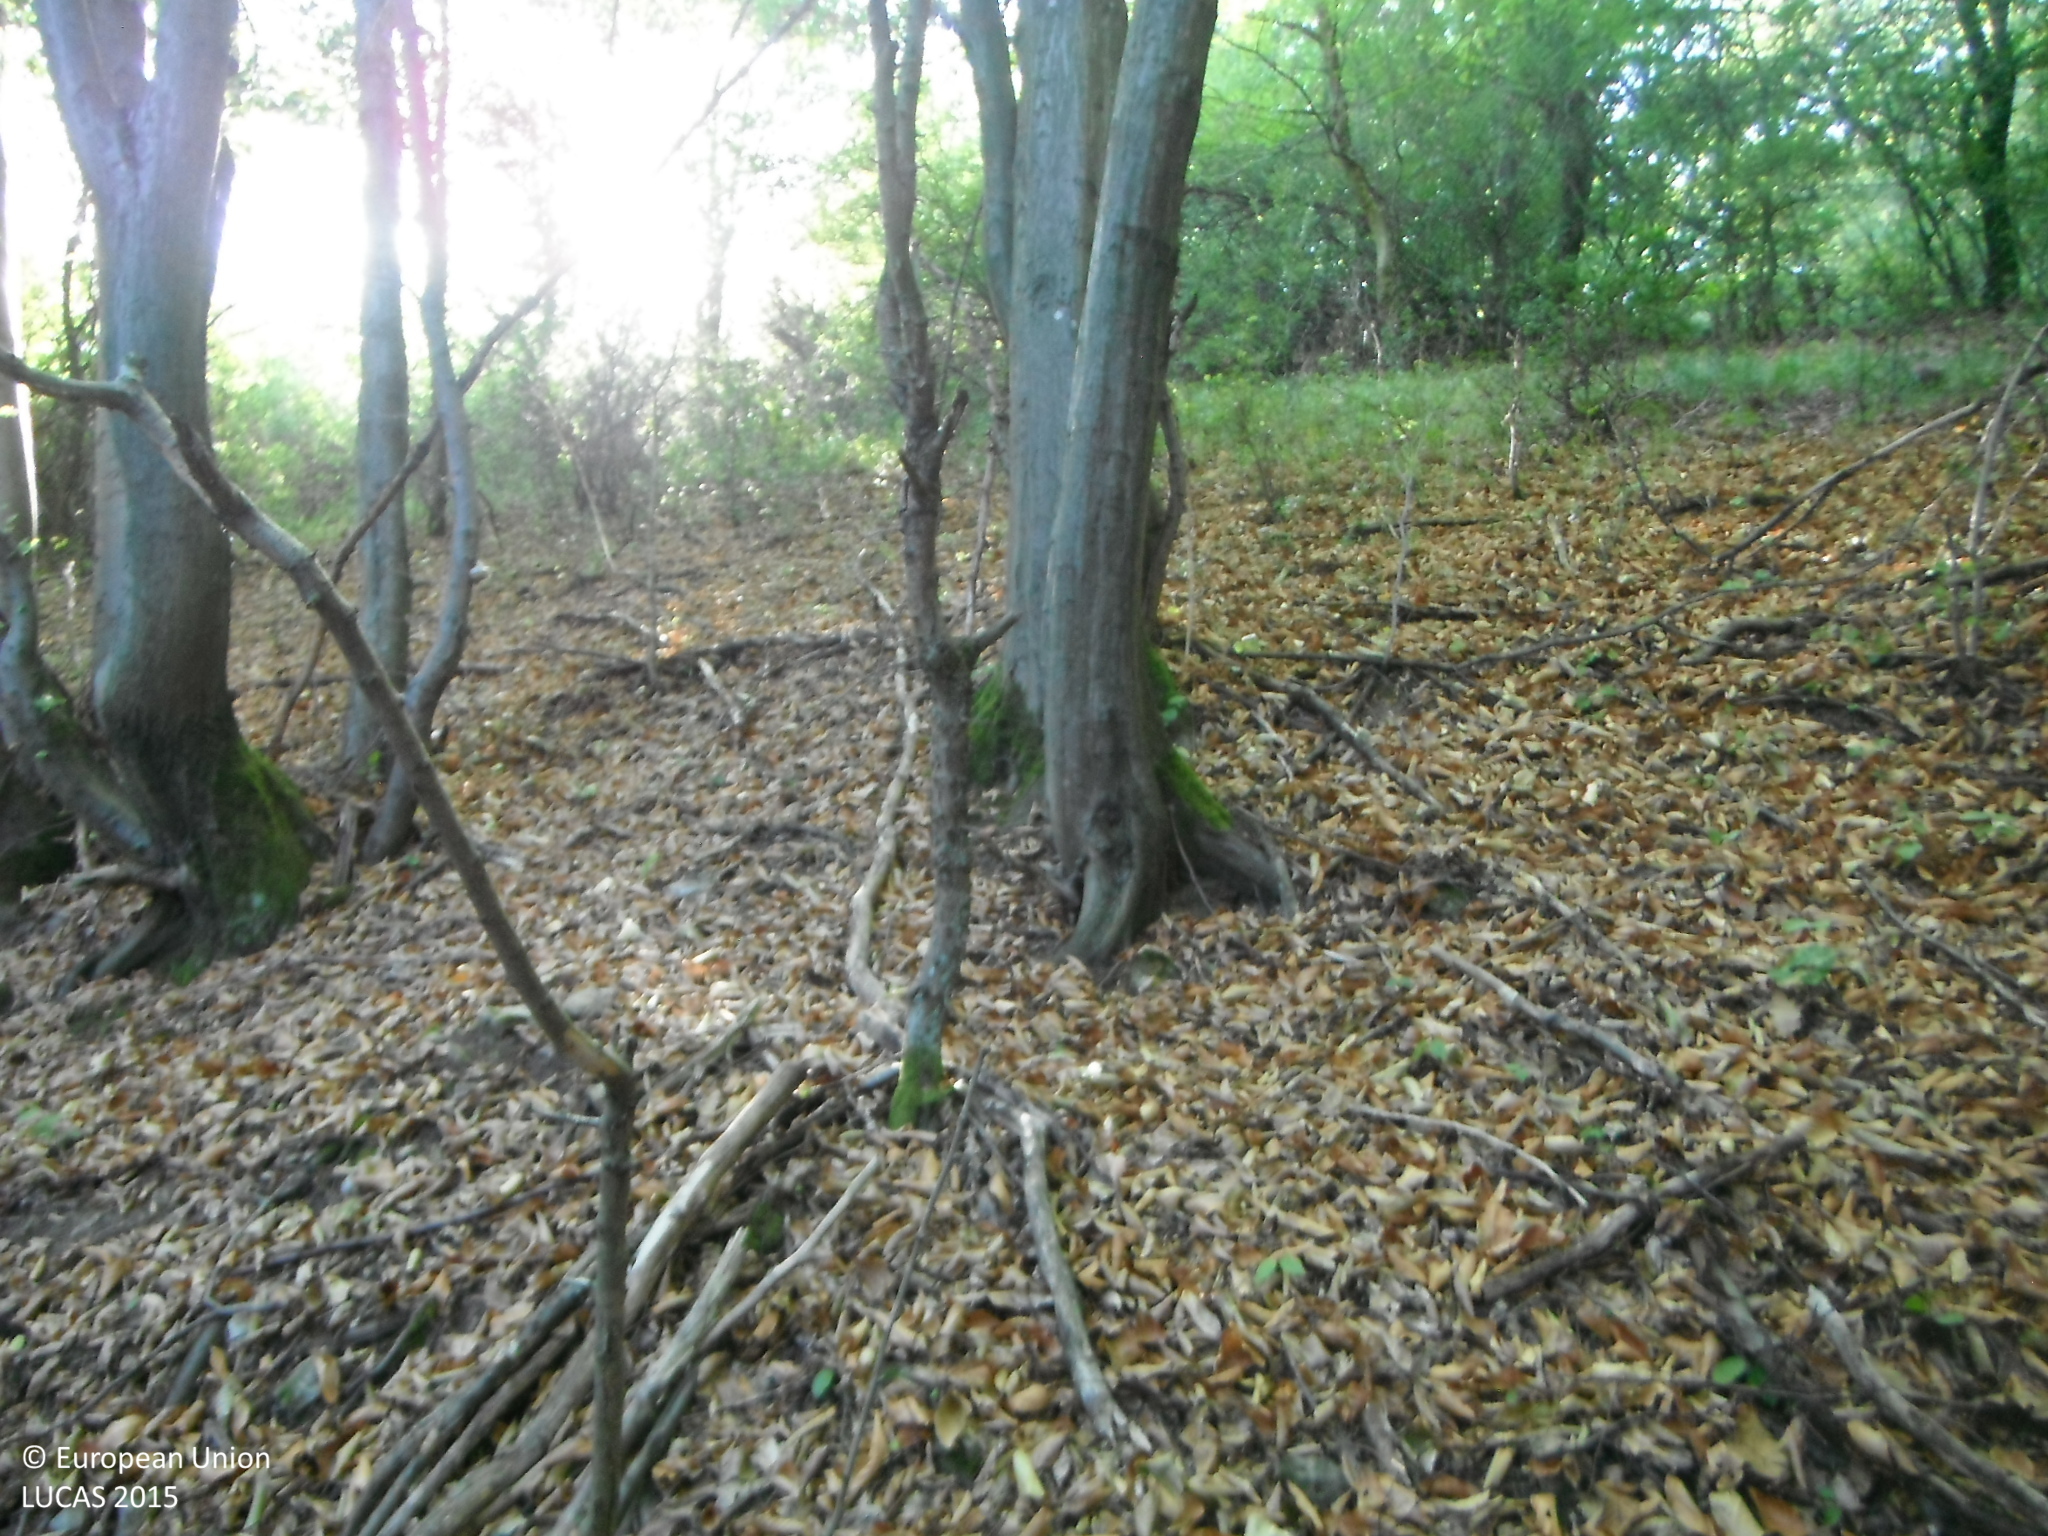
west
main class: Woodland
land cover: Broadleaved woodland
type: beech forest
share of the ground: > 75 %
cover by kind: broadleaved forest trees 90 %, shrubs 5 %
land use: Forestry
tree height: > 5 m
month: September
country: SK
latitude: 48.8316
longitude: 18.3125
